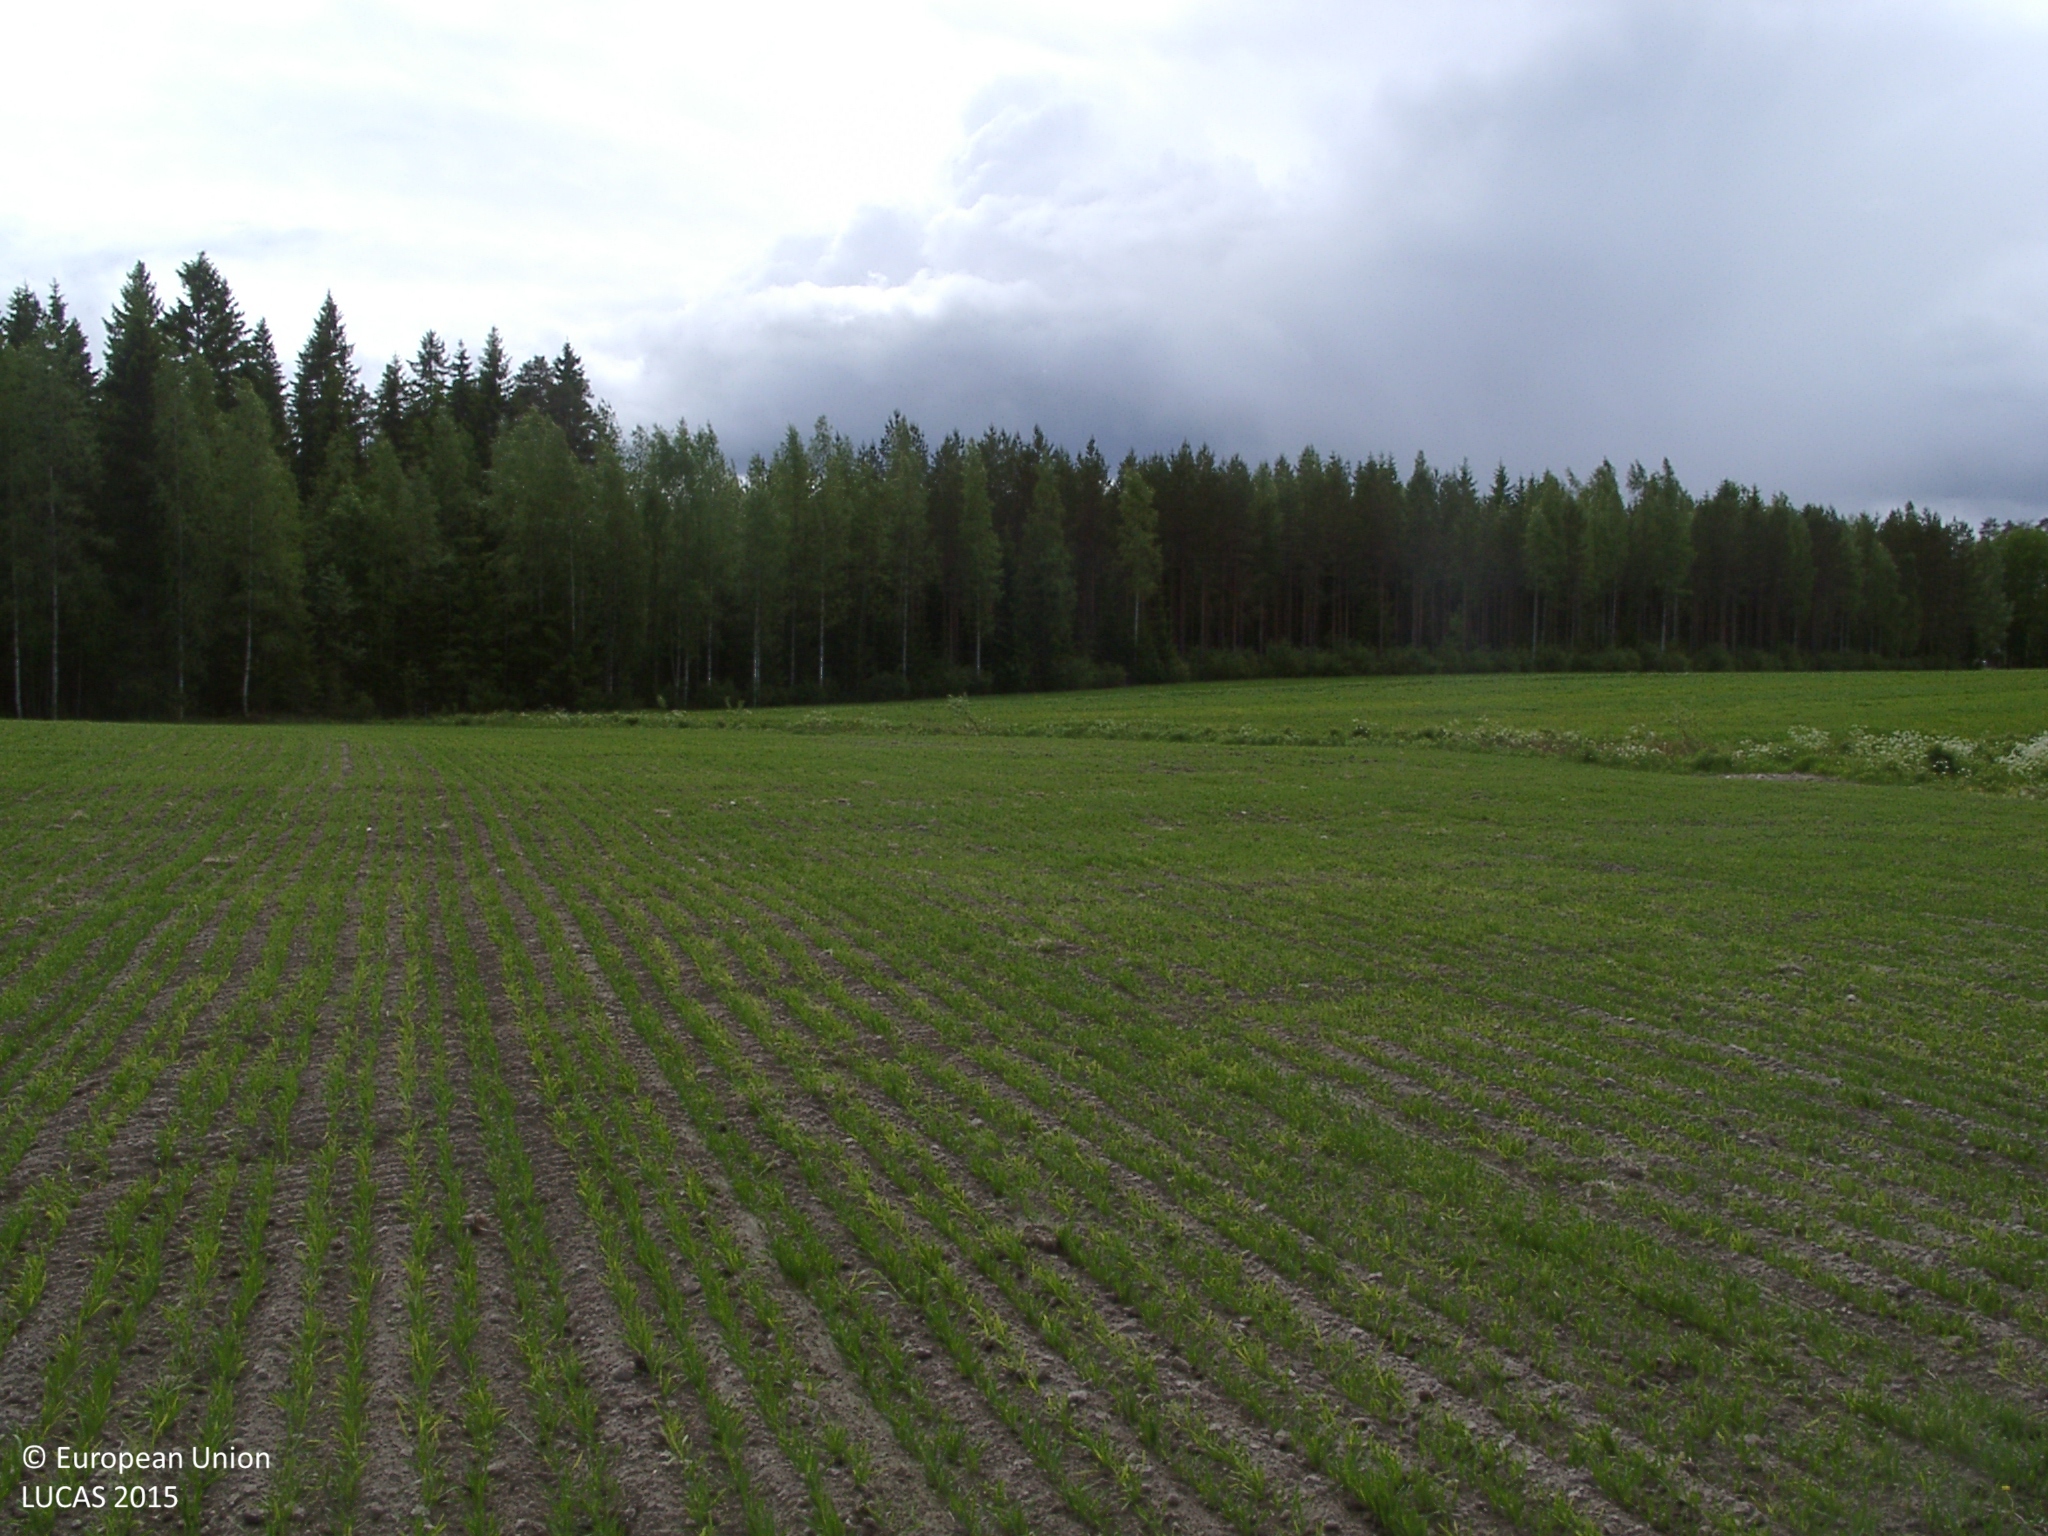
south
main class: Cropland
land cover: Oats
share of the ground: 25 - 50 %
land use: Agriculture (excluding fallow land and kitchen gardens)
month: June
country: FI
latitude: 61.8659
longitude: 24.5248
